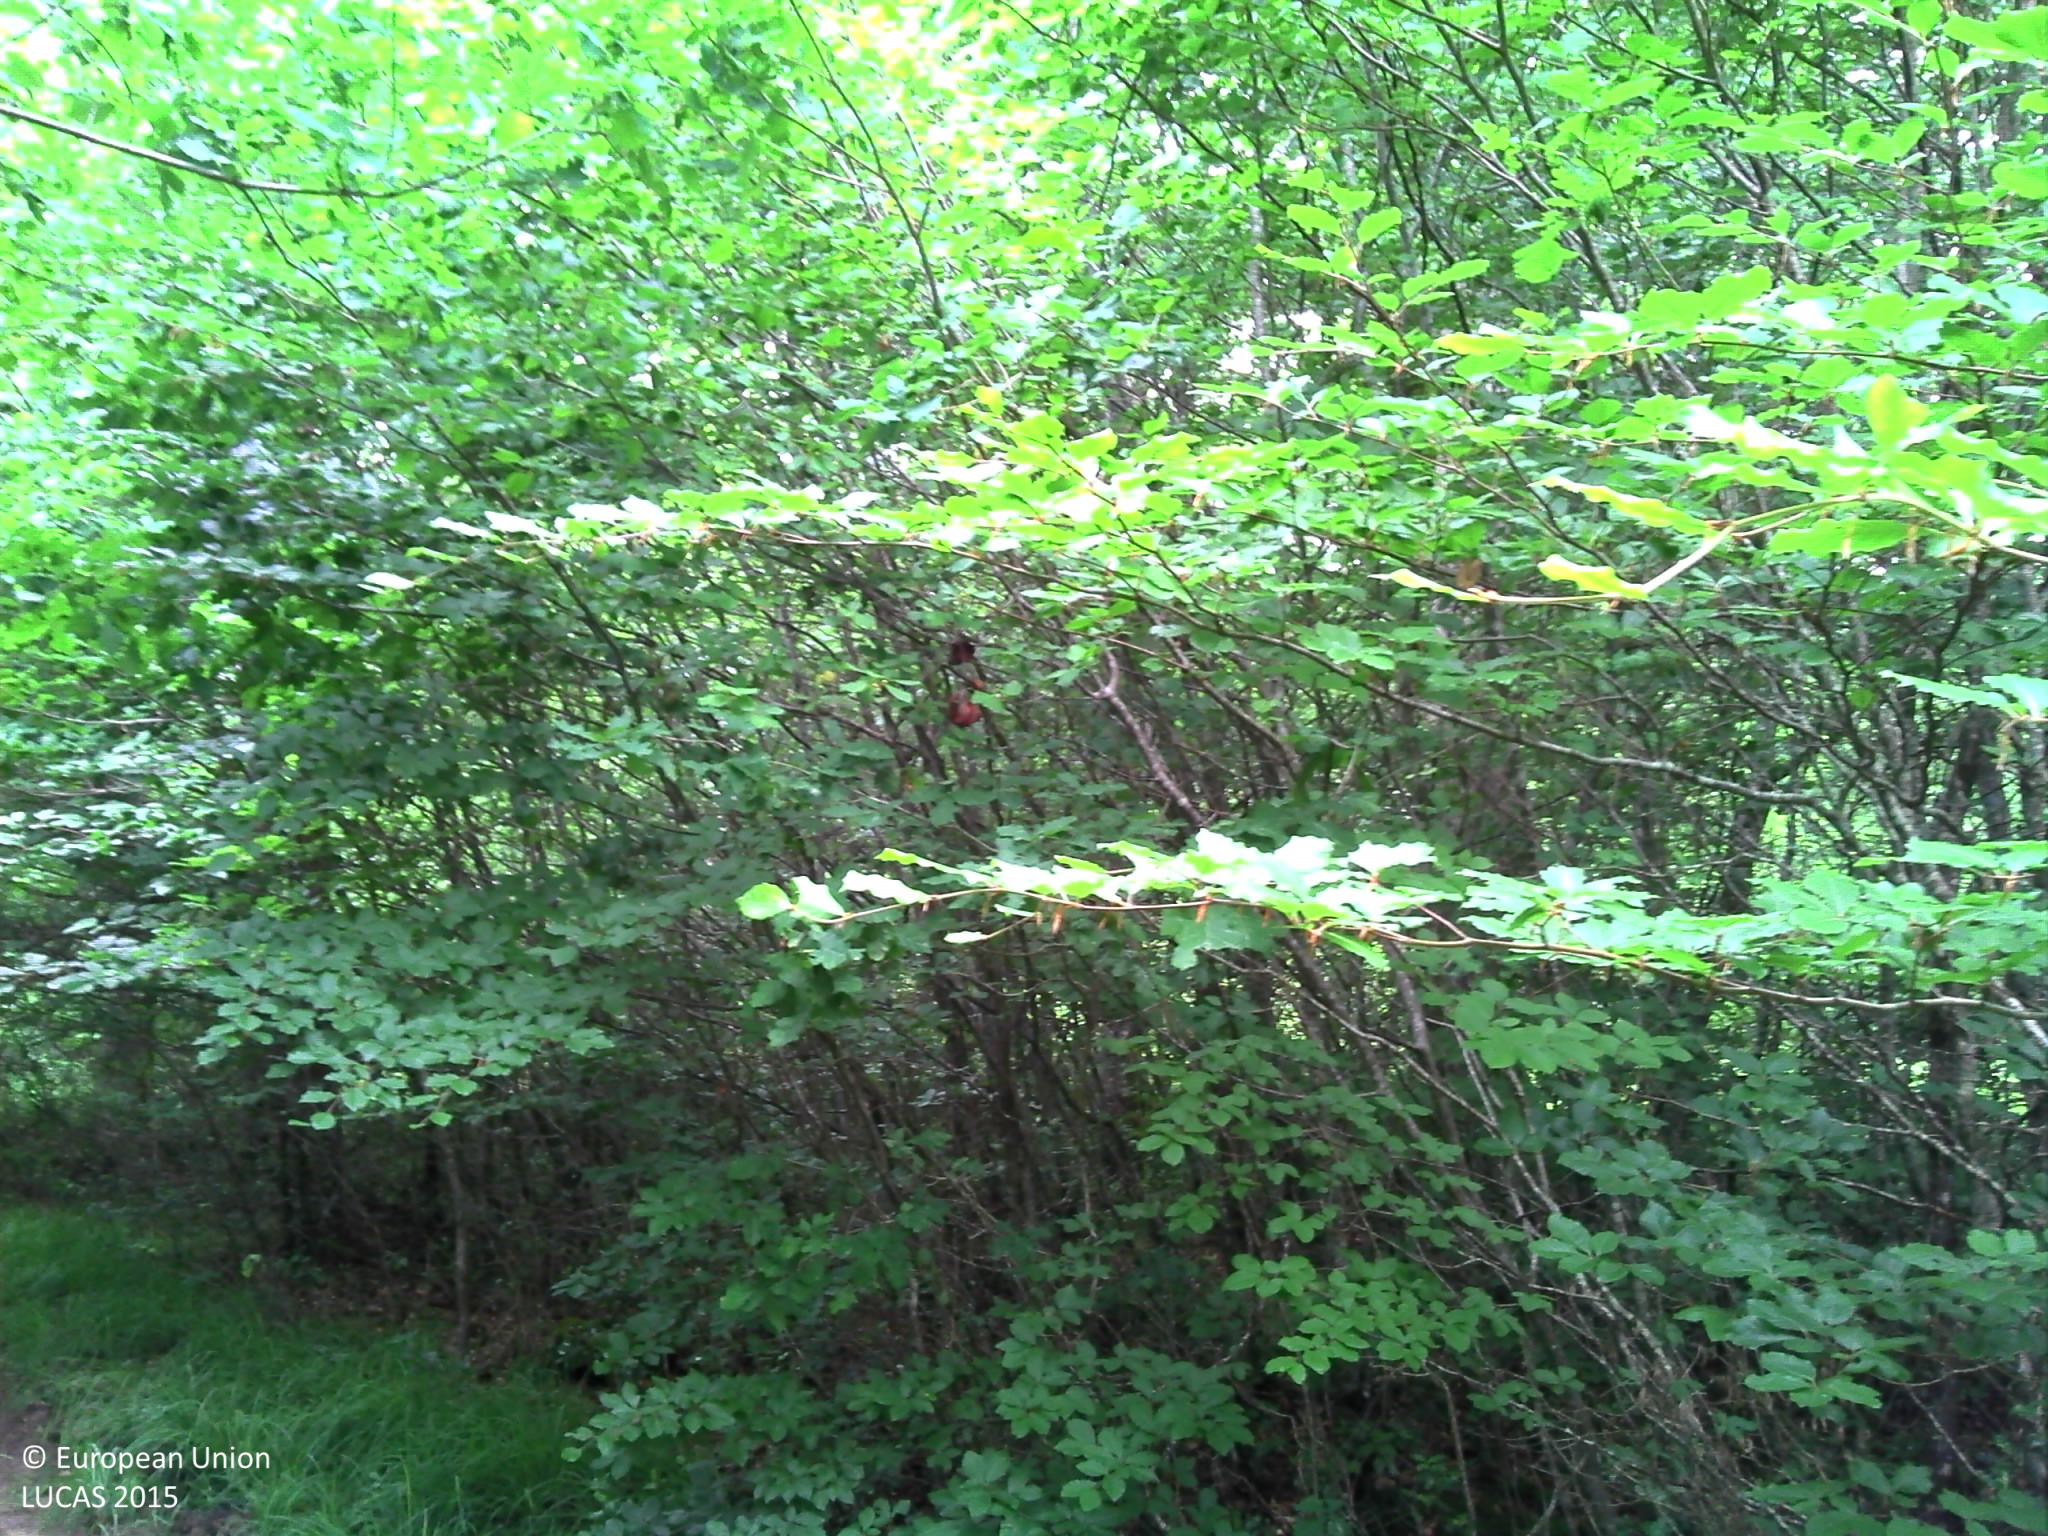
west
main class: Woodland
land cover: Broadleaved woodland
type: acidophilous oak and oak-birch forest
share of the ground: > 75 %
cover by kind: broadleaved forest trees 90 %, shrubs 10 %
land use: Forestry
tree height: > 5 m
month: June
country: FR
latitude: 46.6435
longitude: 2.6923
